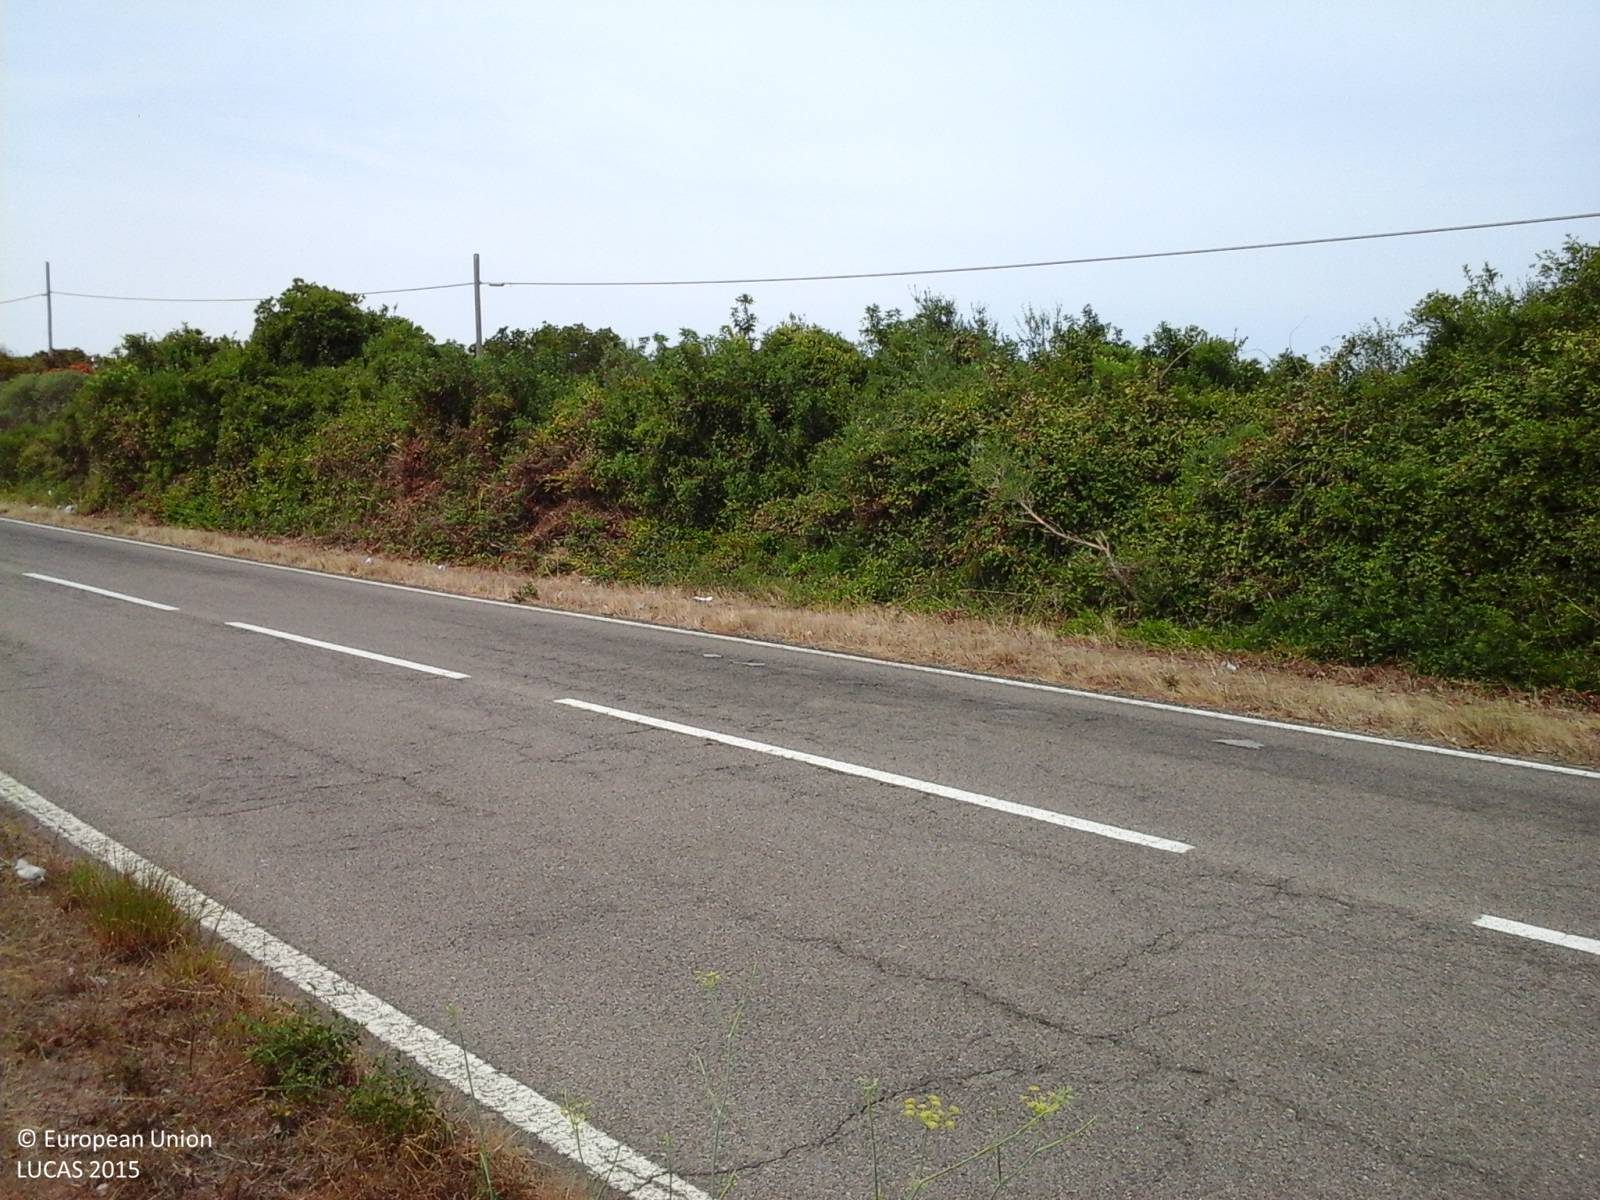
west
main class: Shrubland
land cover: Shrubland without tree cover
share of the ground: > 75 %
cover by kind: shrubs 55 %, herbaceous plants 45 %
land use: Abandoned areas
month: August
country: IT
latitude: 41.1133
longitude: 9.0634
